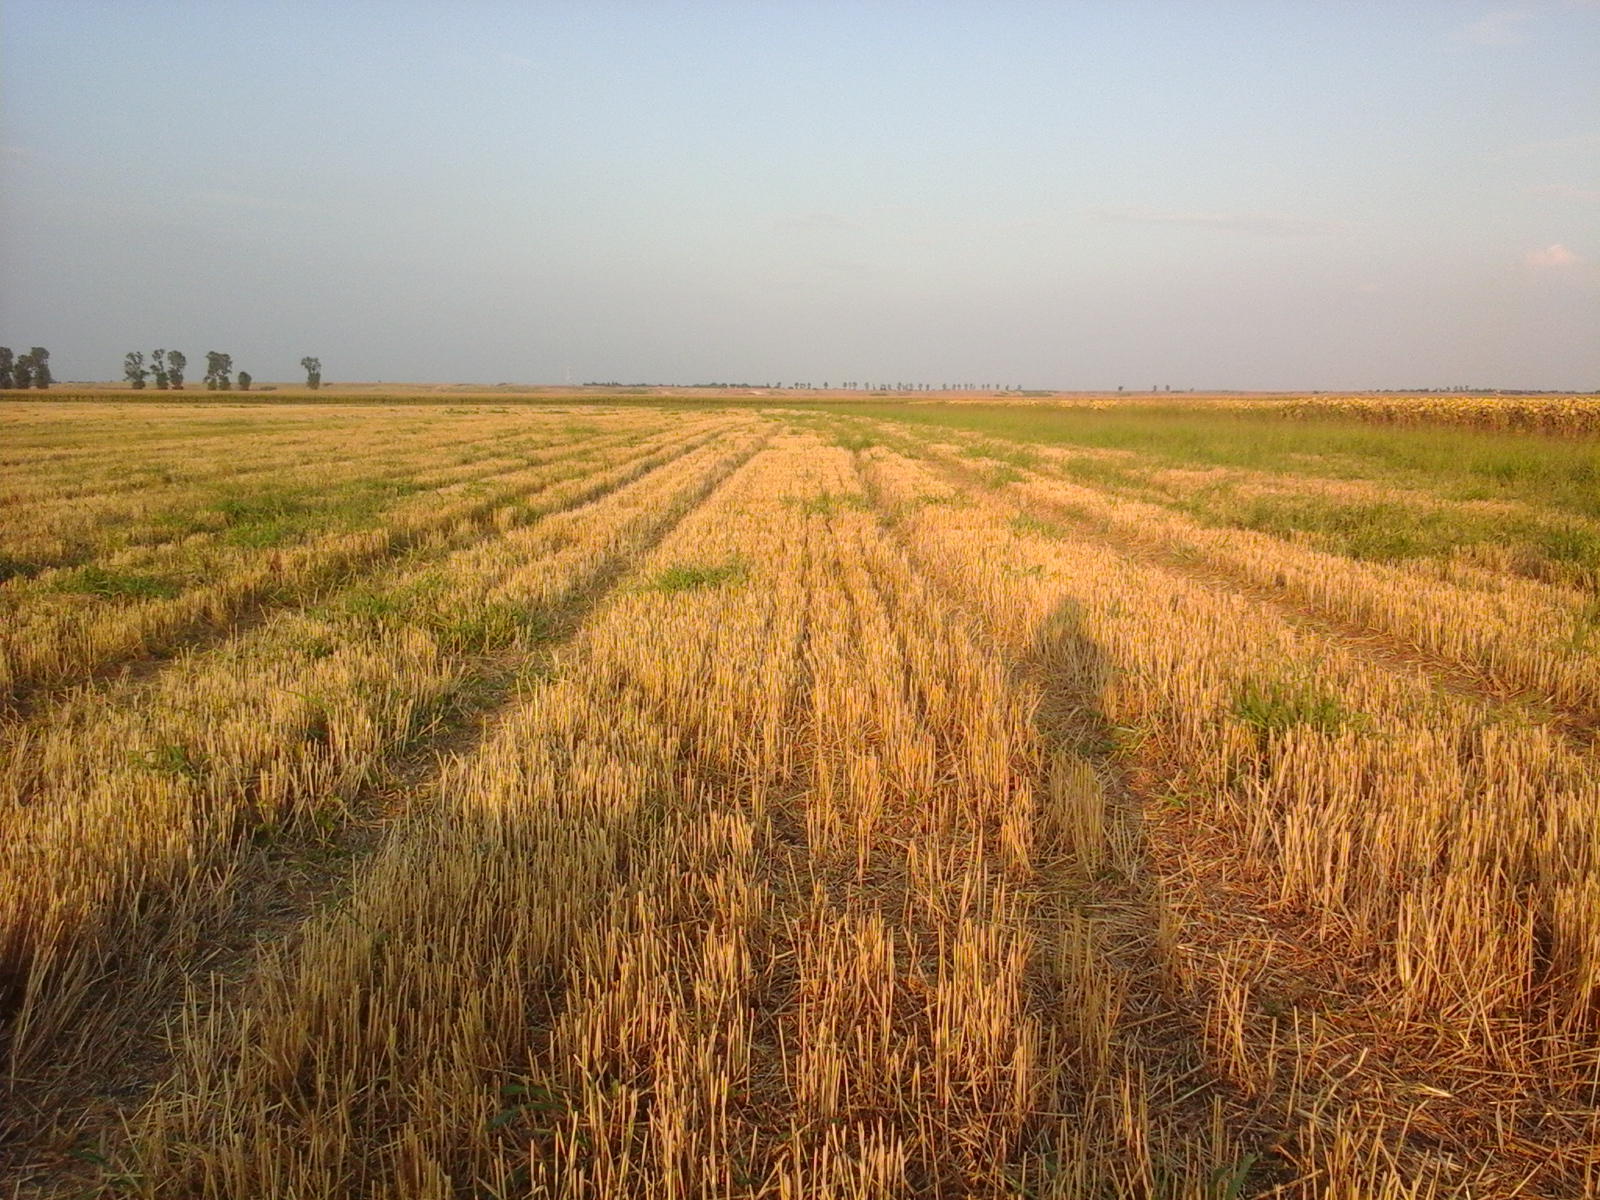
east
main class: Cropland
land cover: Common wheat
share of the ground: 50 - 75 %
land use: Agriculture (excluding fallow land and kitchen gardens)
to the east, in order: Common wheat
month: August
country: RO
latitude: 44.0010
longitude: 23.5815
